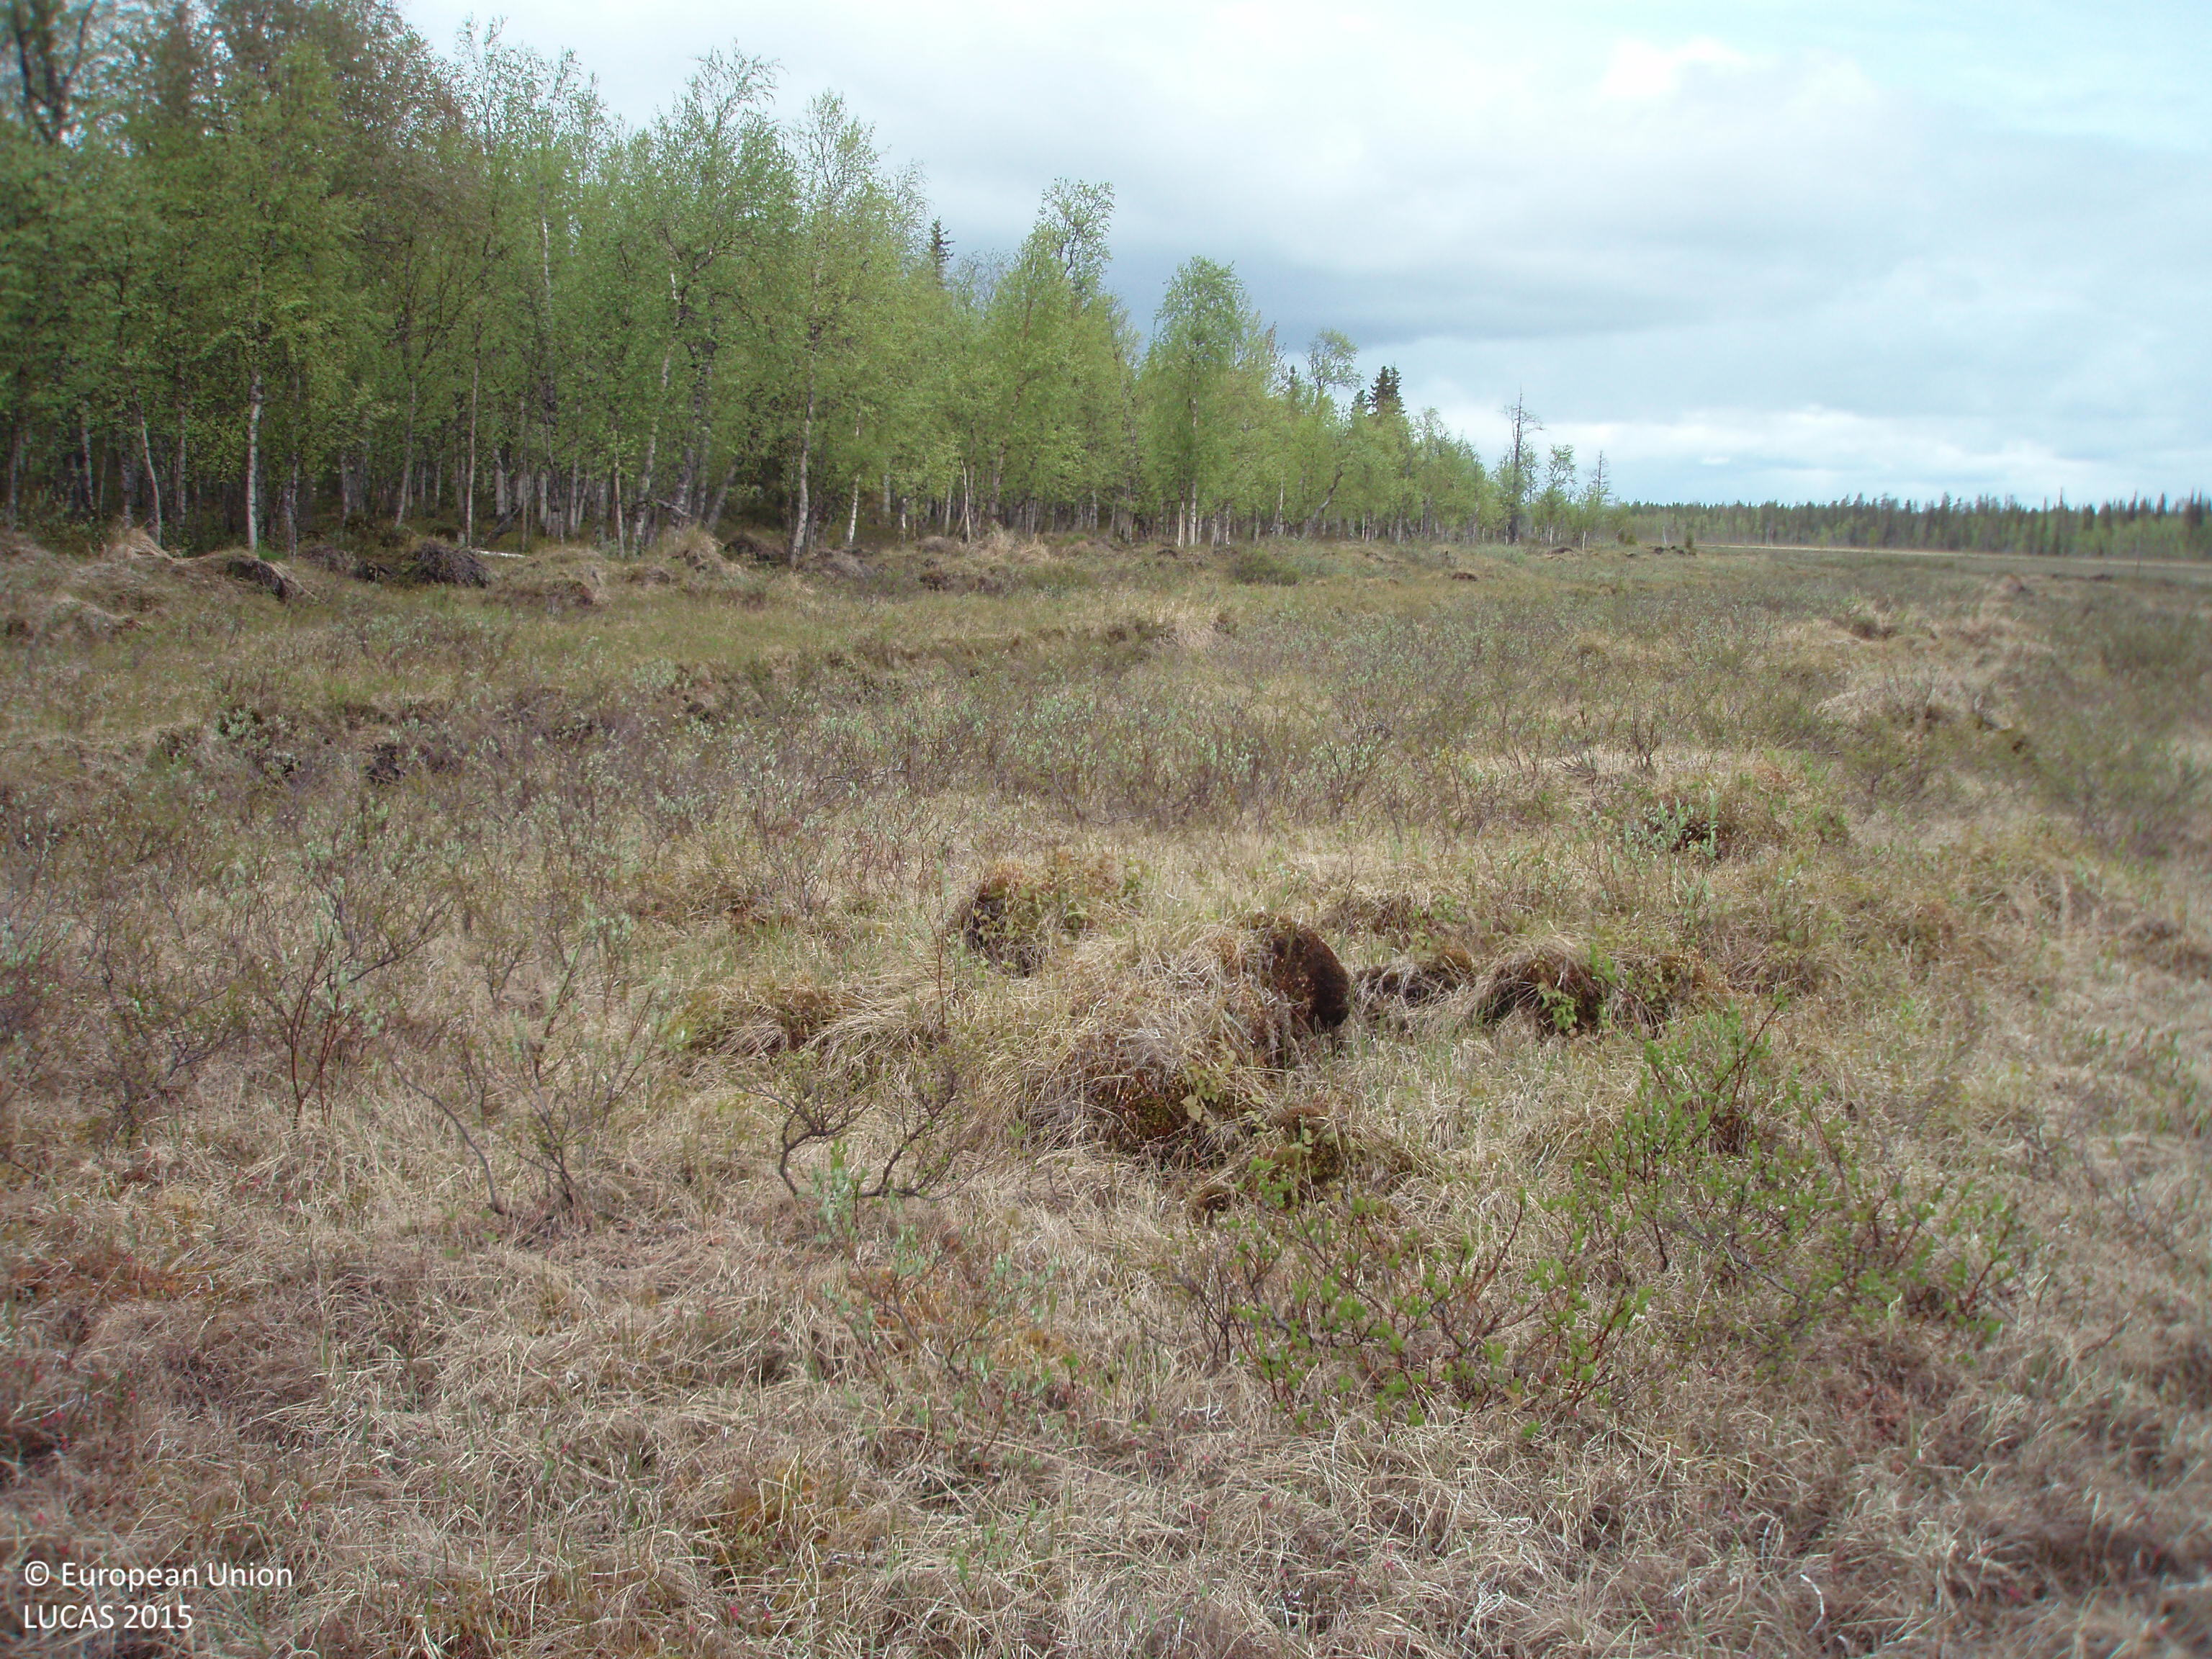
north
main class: Shrubland
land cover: Shrubland without tree cover
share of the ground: > 75 %
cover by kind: shrubs 60 %, herbaceous plants 40 %
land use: Semi-natural and natural areas not in use
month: June
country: FI
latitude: 67.9625
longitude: 26.7637
